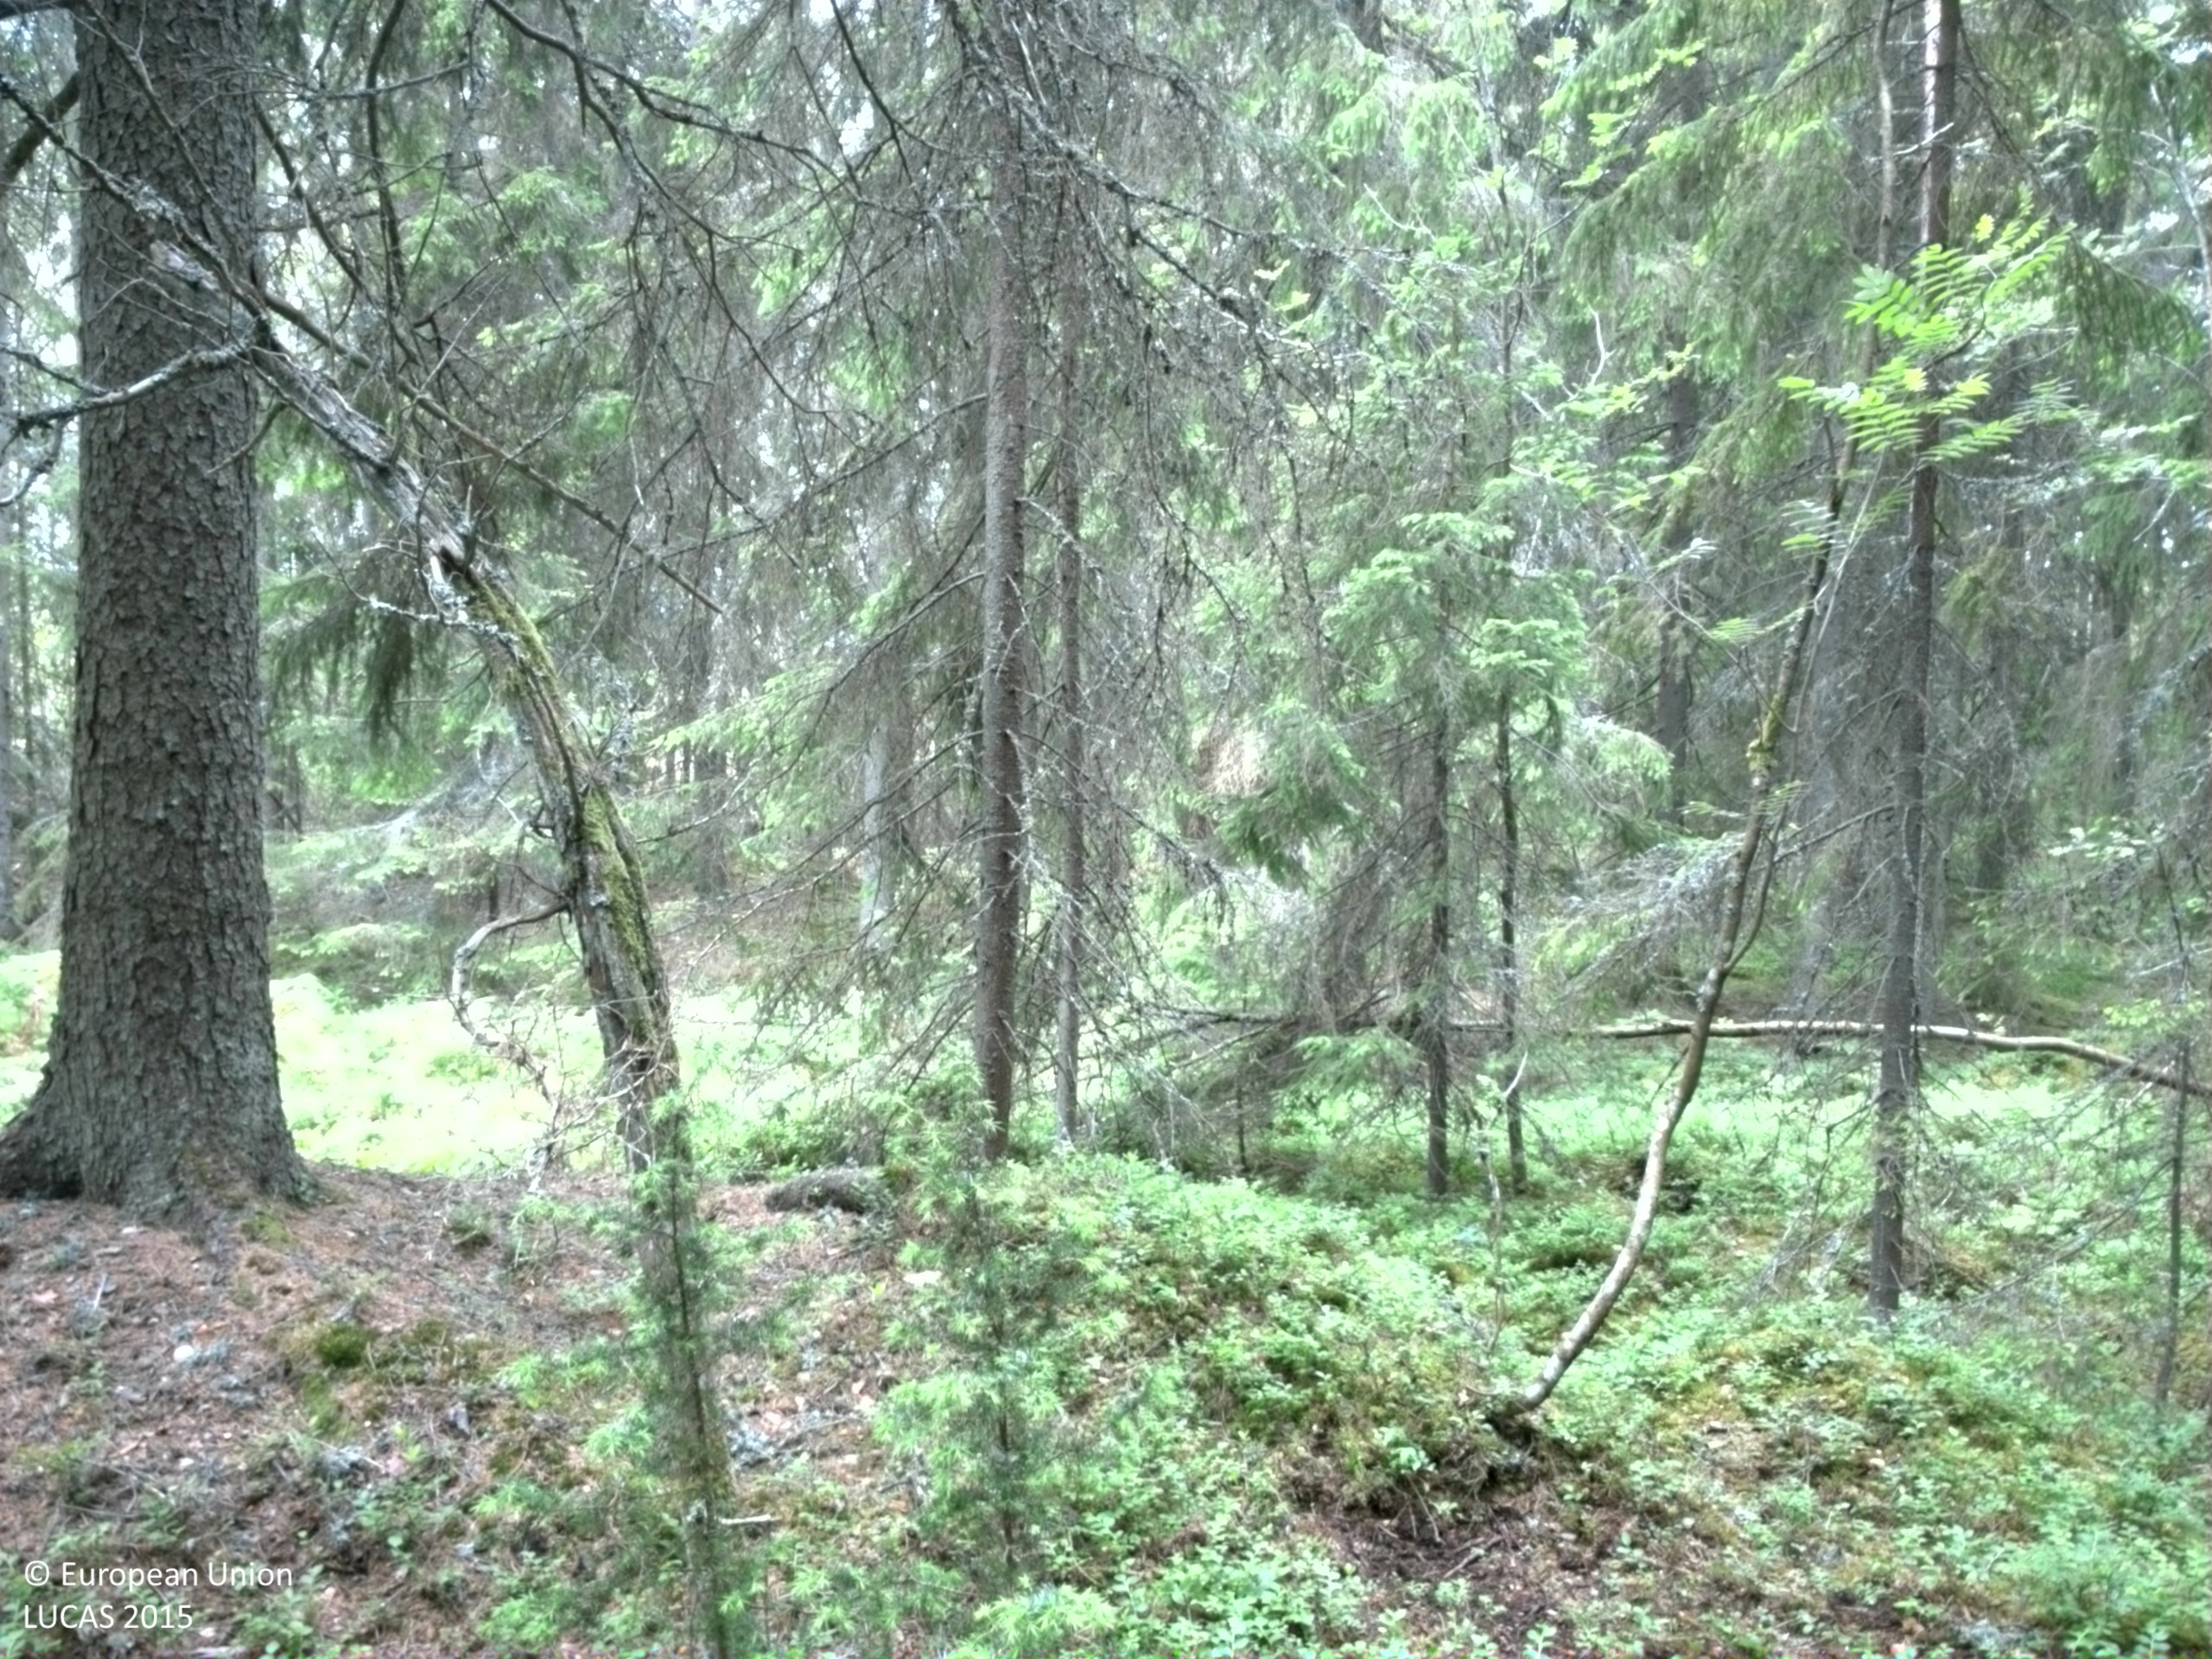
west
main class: Woodland
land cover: Spruce dominated coniferous woodland
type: boreal forest
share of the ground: > 75 %
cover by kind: coniferous forest trees 75 %, shrubs 15 %, lichens and mosses 5 %
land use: Forestry
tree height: > 5 m
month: June
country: SE
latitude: 60.1908
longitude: 17.2955
